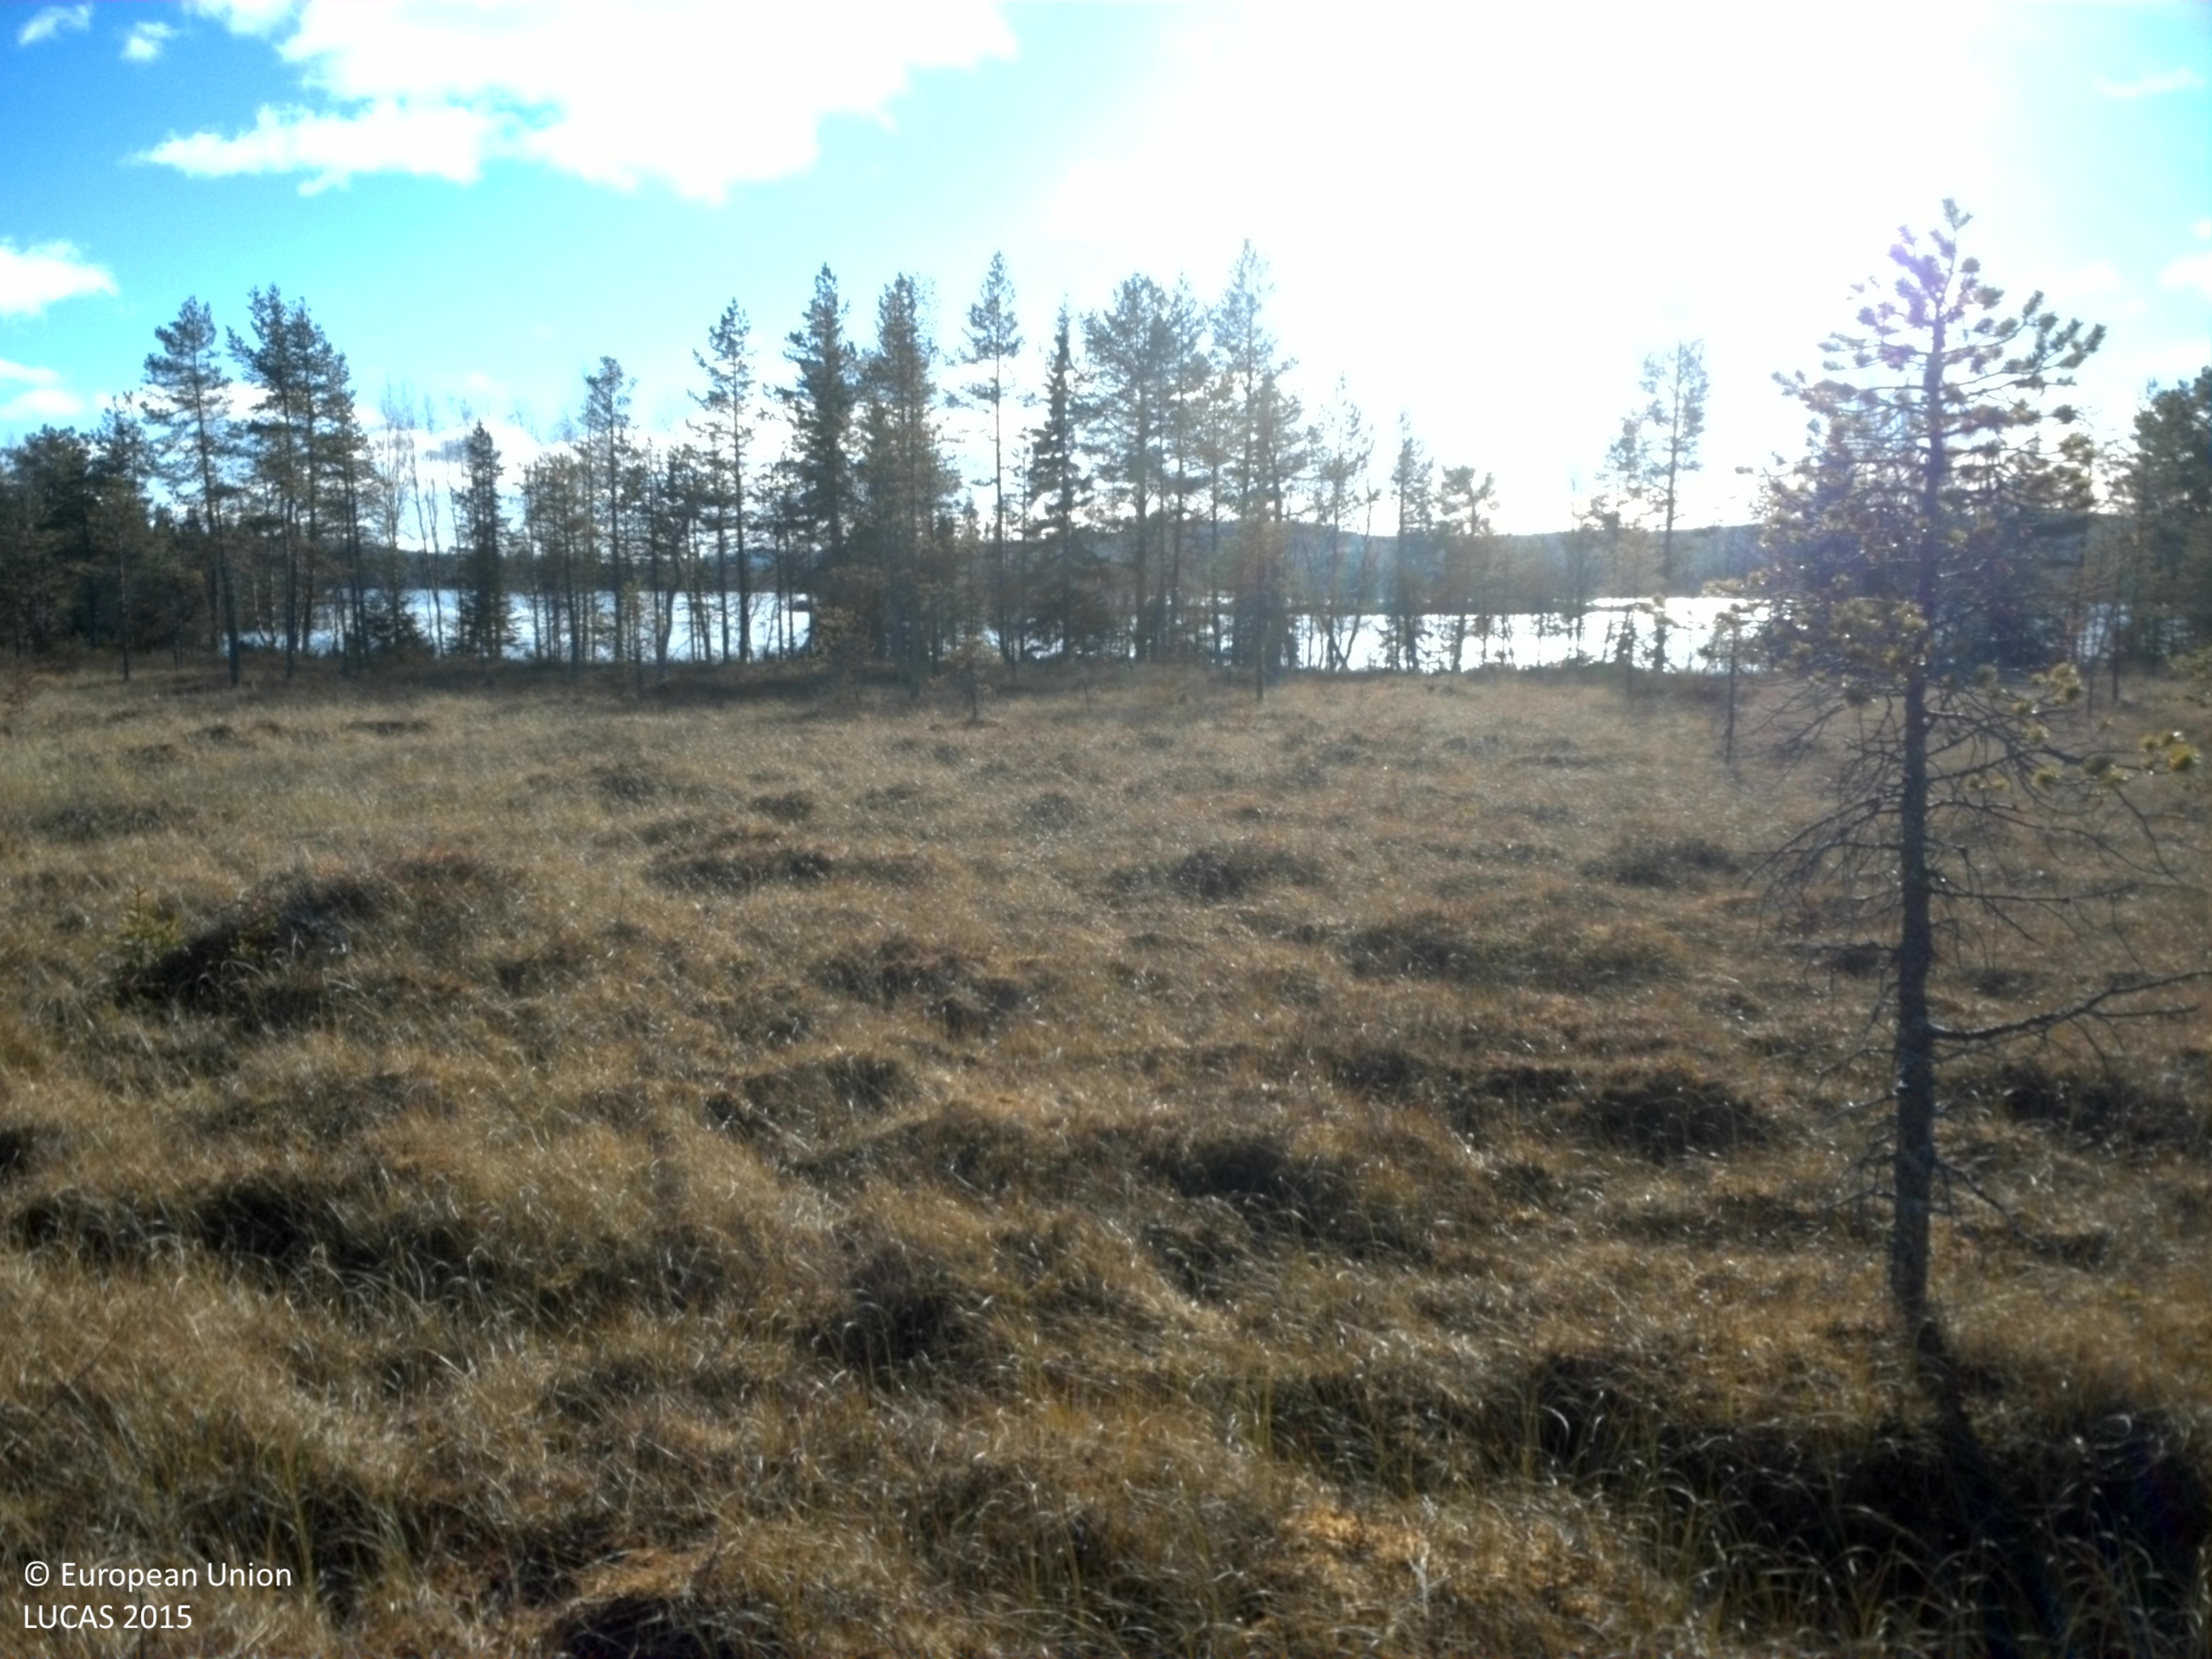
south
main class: Woodland
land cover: Pine dominated coniferous woodland
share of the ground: 10 - 25 %
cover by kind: herbaceous plants 70 %, coniferous forest trees 10 %, shrubs 10 %, lichens and mosses 10 %
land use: Semi-natural and natural areas not in use
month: October
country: SE
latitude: 64.7987
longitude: 17.5635
